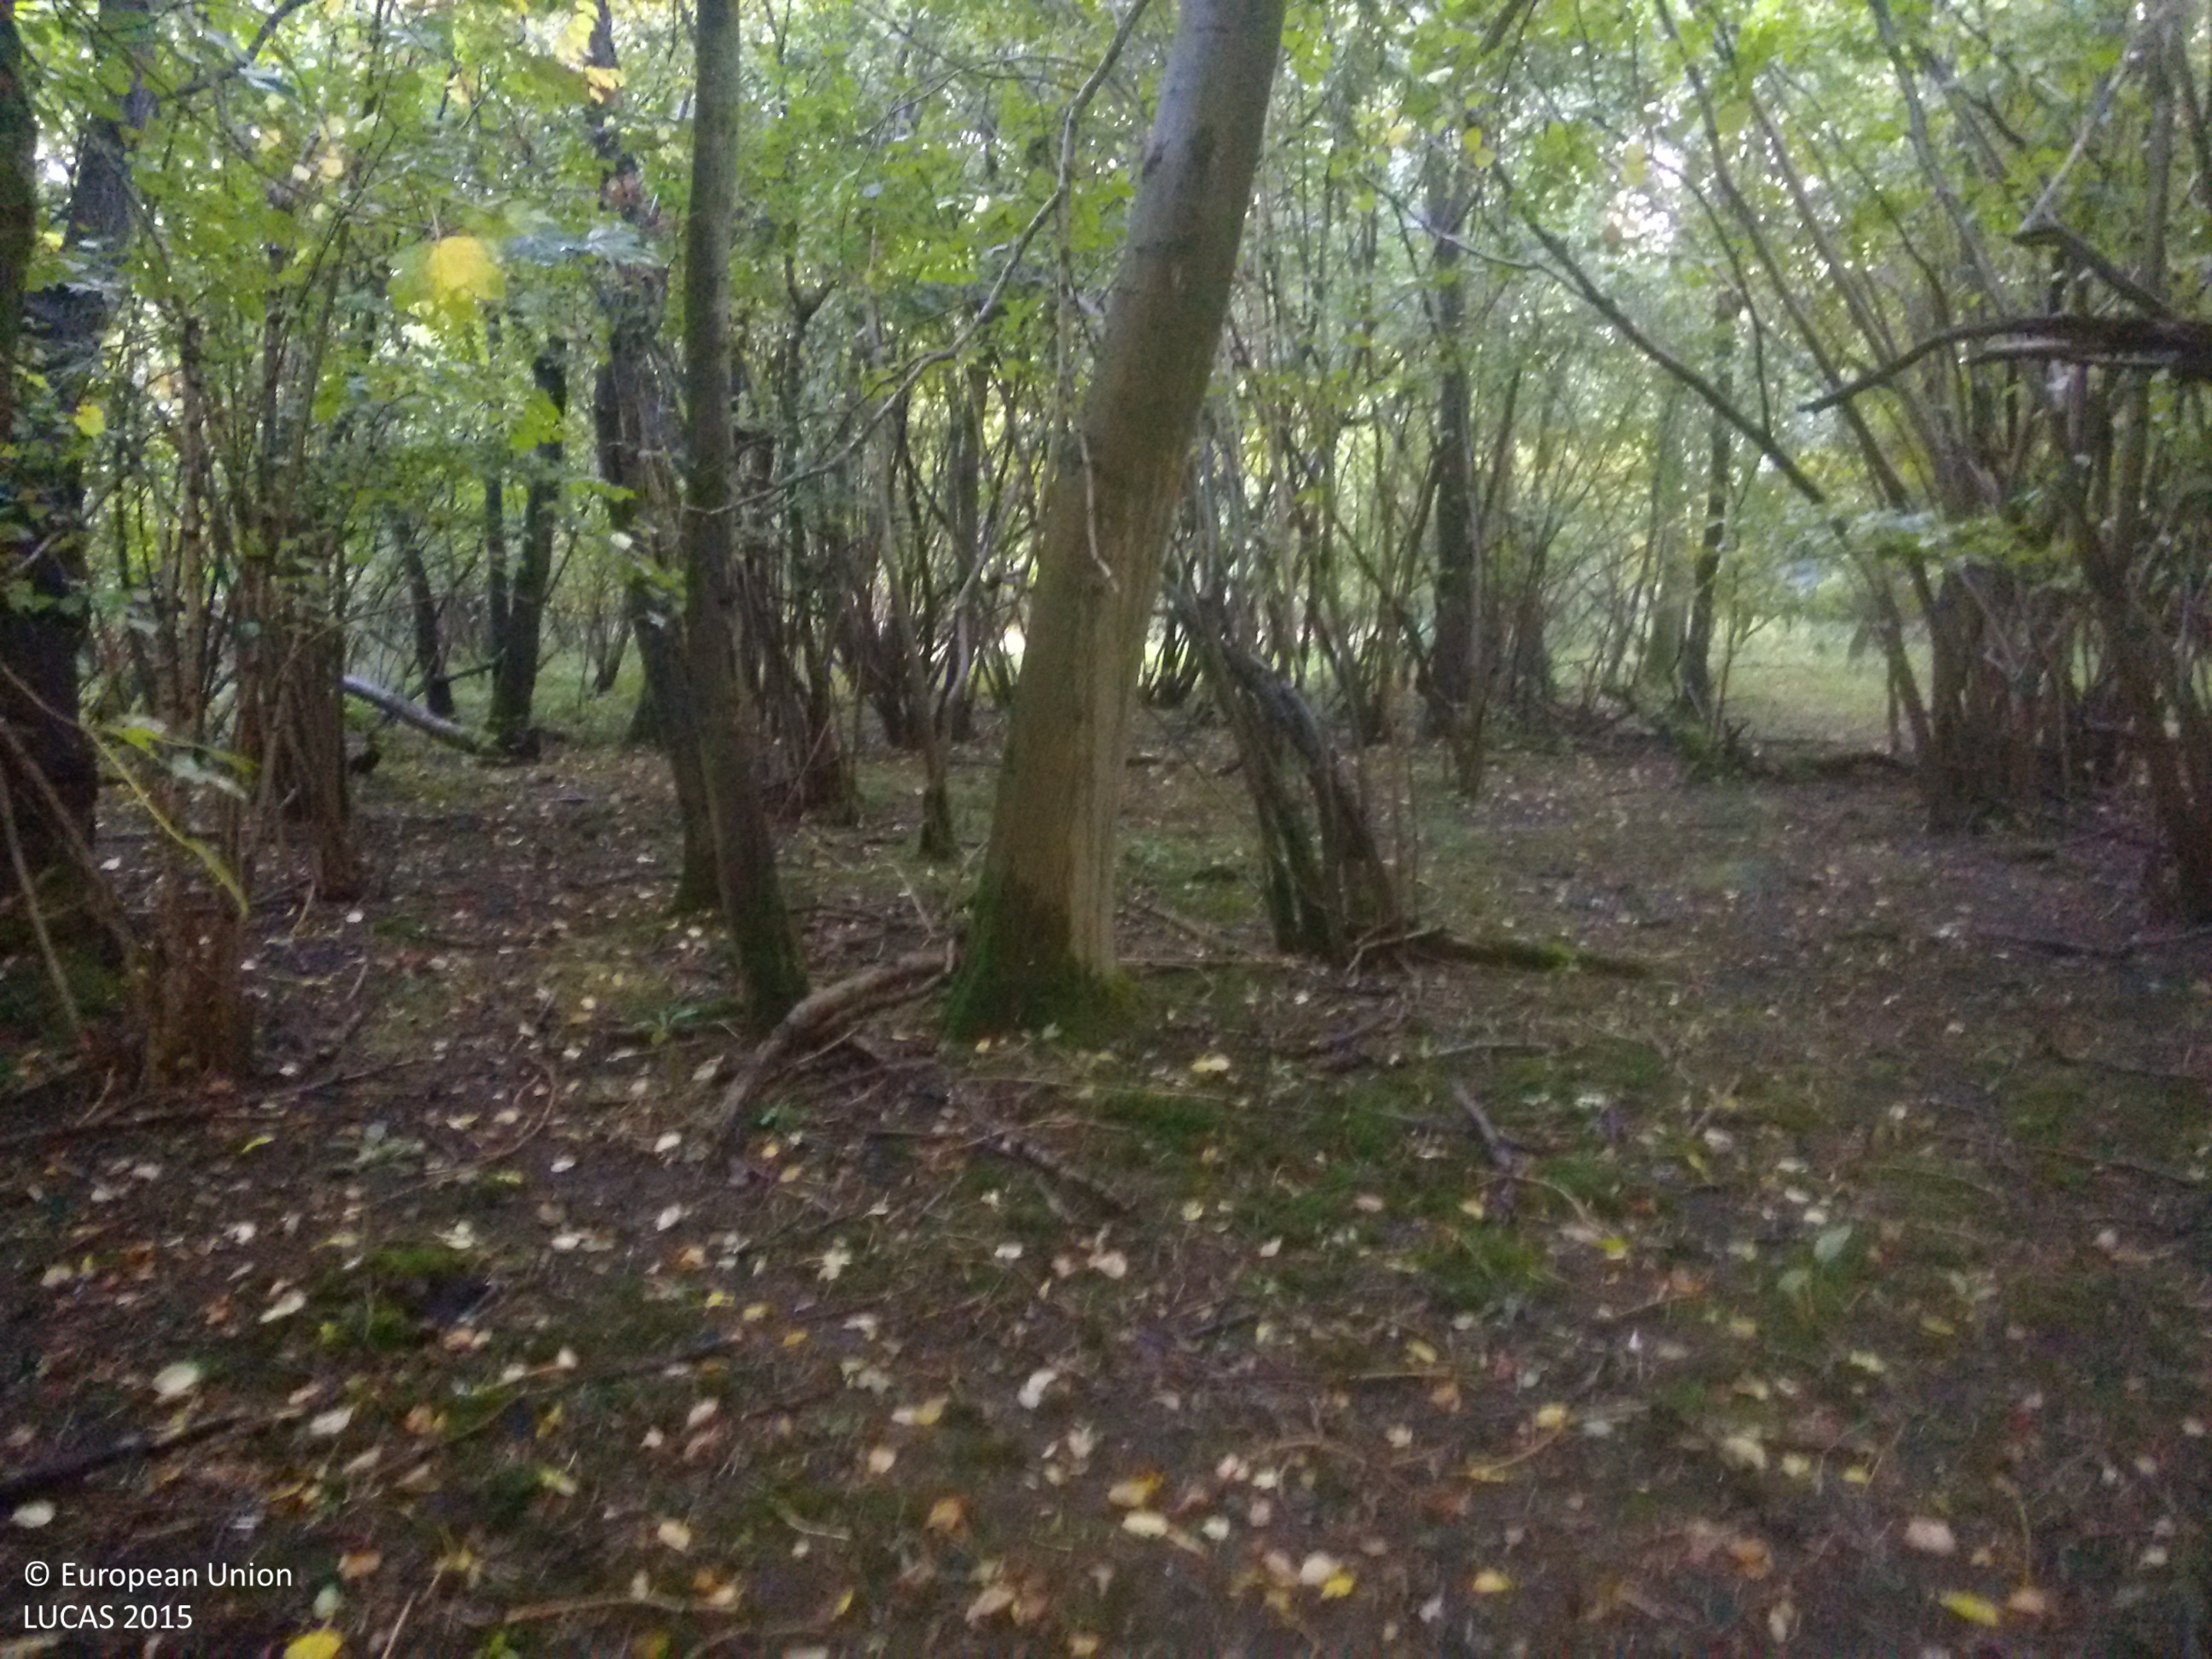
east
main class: Woodland
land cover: Broadleaved woodland
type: mesophytic deciduous forest
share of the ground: > 75 %
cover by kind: broadleaved forest trees 75 %, shrubs 25 %
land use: Semi-natural and natural areas not in use
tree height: > 5 m
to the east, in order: Broadleaved woodland; Ditches and canals; Broadleaved woodland; Groves; Grassland without tree/shrub cover; Tracks; Common wheat
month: October
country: GB
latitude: 52.0650
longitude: 0.2402
